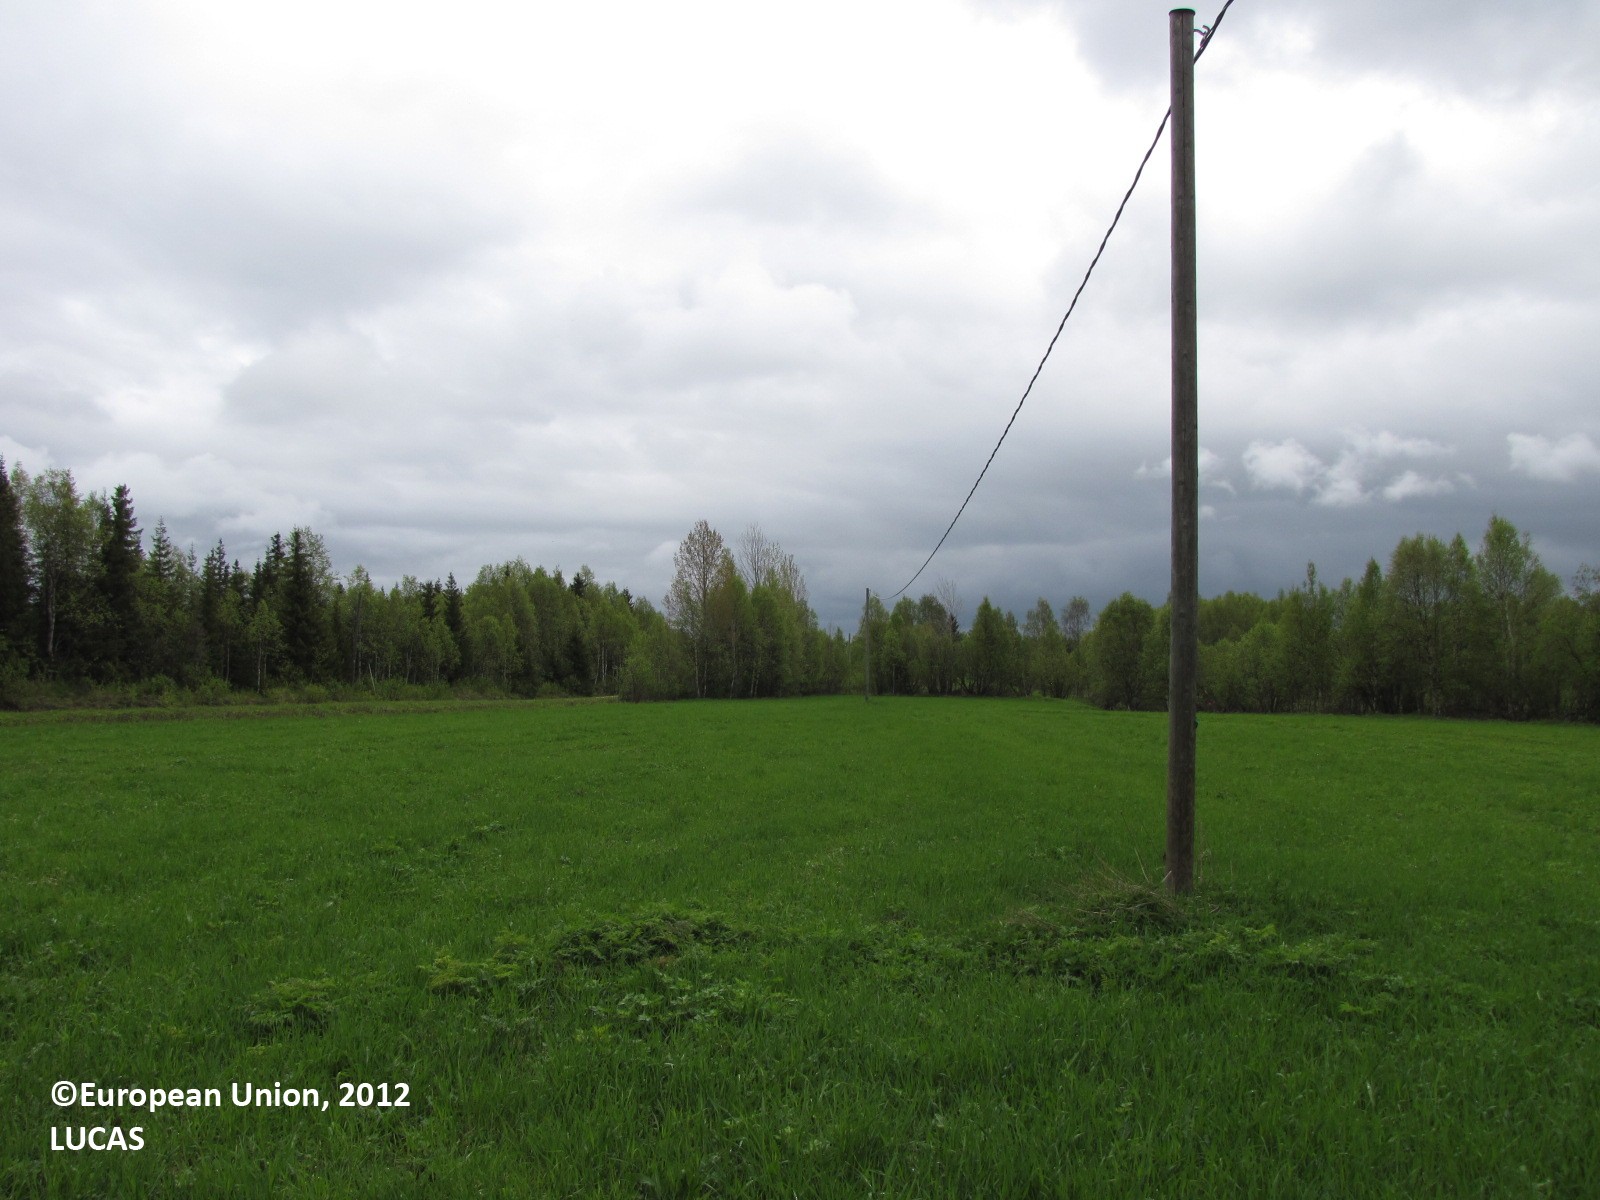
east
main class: Grassland
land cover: Grassland without tree/shrub cover
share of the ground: > 75 %
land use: Agriculture (excluding fallow land and kitchen gardens)
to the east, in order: Grassland without tree/shrub cover; Electric lines; Grassland without tree/shrub cover; Single bushes/trees; Ditches and canals; Grassland with sparse tree/shrub cover; Spontaneously vegetated surfaces; Paved roads, cycling and walking lanes; Grass margins; Ditches and canals; Spruce dominated mixed woodland; Ditches and canals; Spruce dominated mixed woodland; Ditches and canals; Spruce dominated mixed woodland
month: June
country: FI
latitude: 65.9492
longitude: 24.4094
